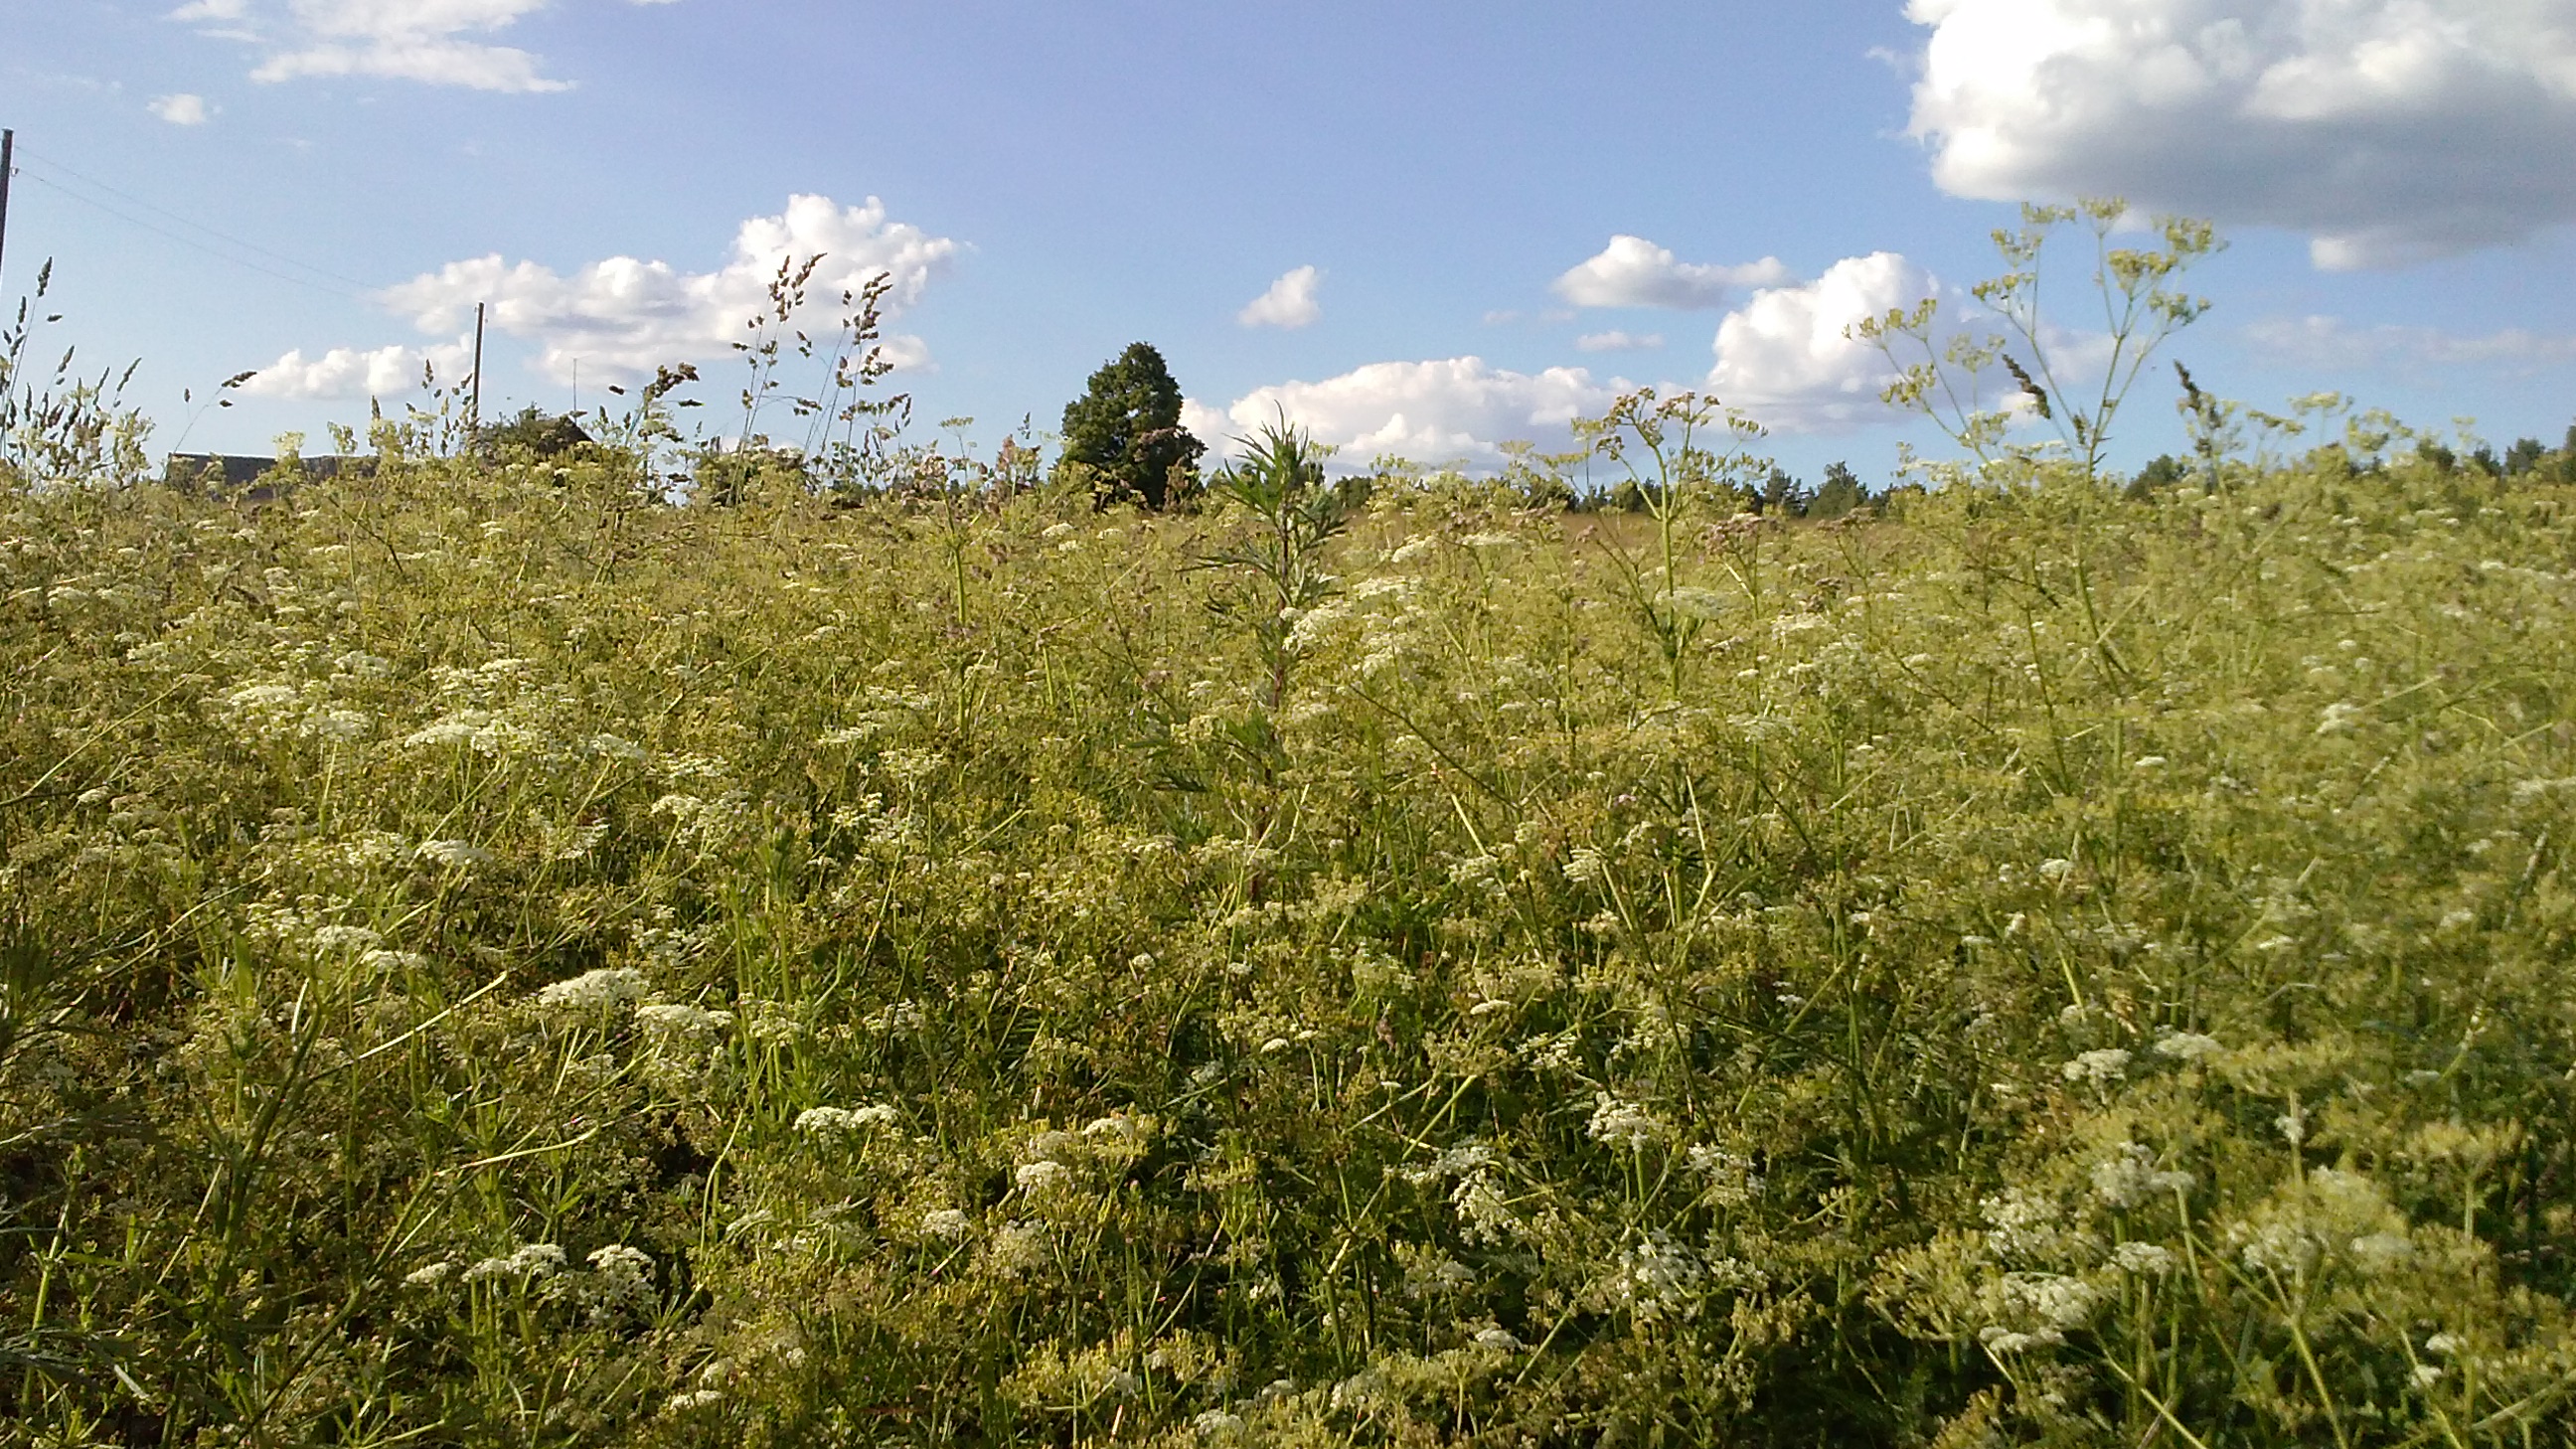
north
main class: Grassland
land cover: Spontaneously vegetated surfaces
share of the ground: > 75 %
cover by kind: herbaceous plants 100 %
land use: Semi-natural and natural areas not in use
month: June
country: LV
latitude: 56.5300
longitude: 27.9653
